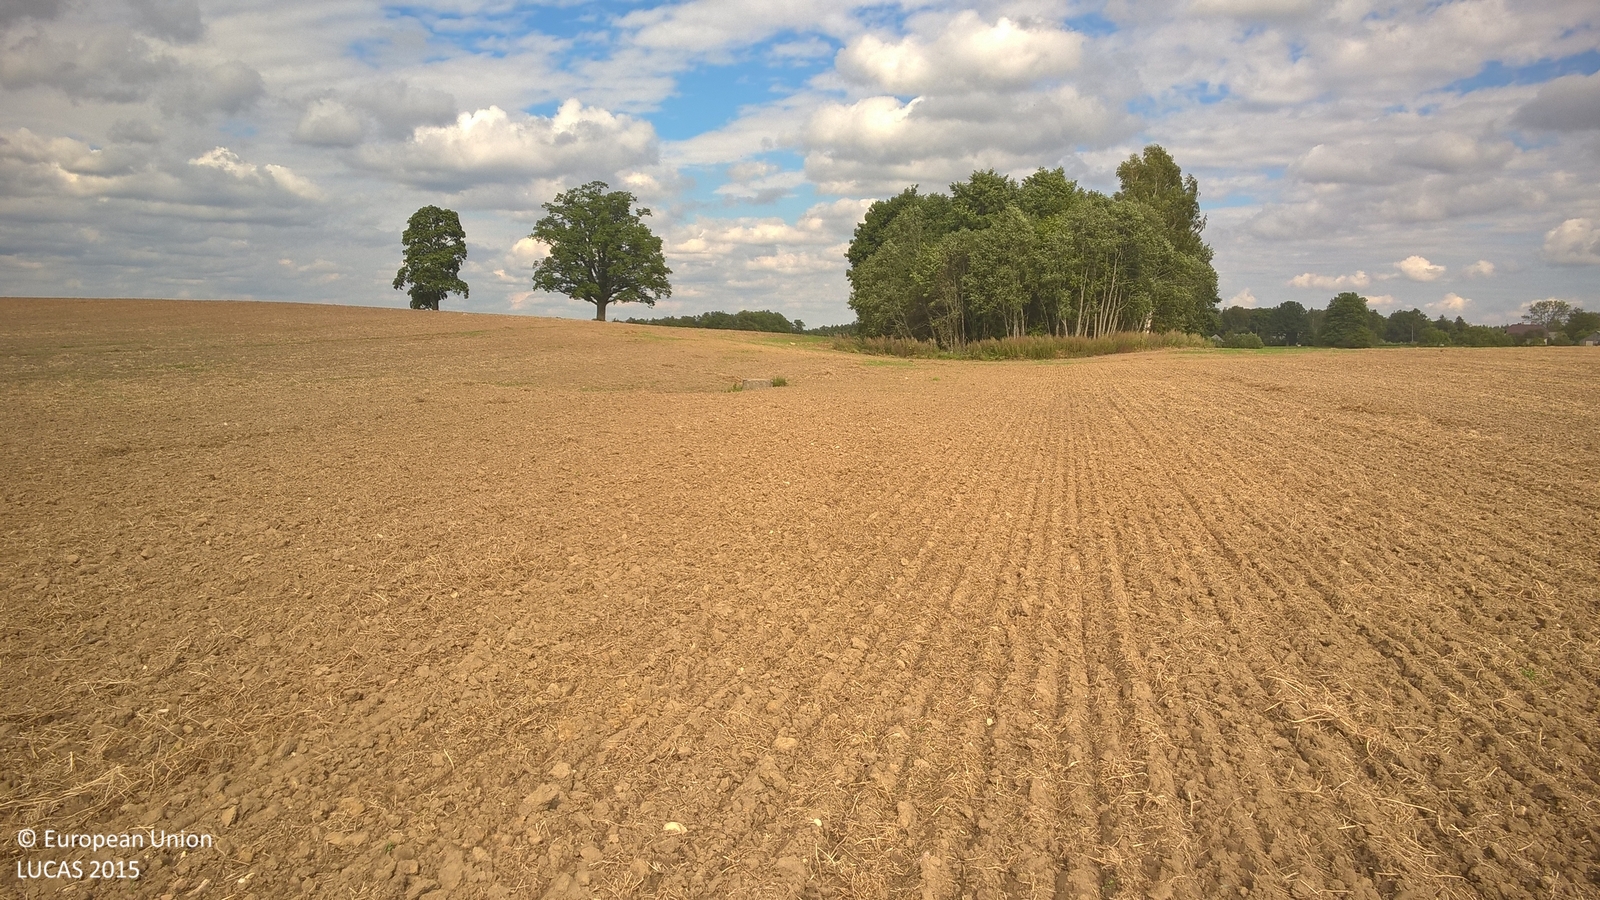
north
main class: Cropland
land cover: Dry pulses
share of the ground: < 10 %
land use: Agriculture (excluding fallow land and kitchen gardens)
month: September
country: LV
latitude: 57.3248
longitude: 25.5458
